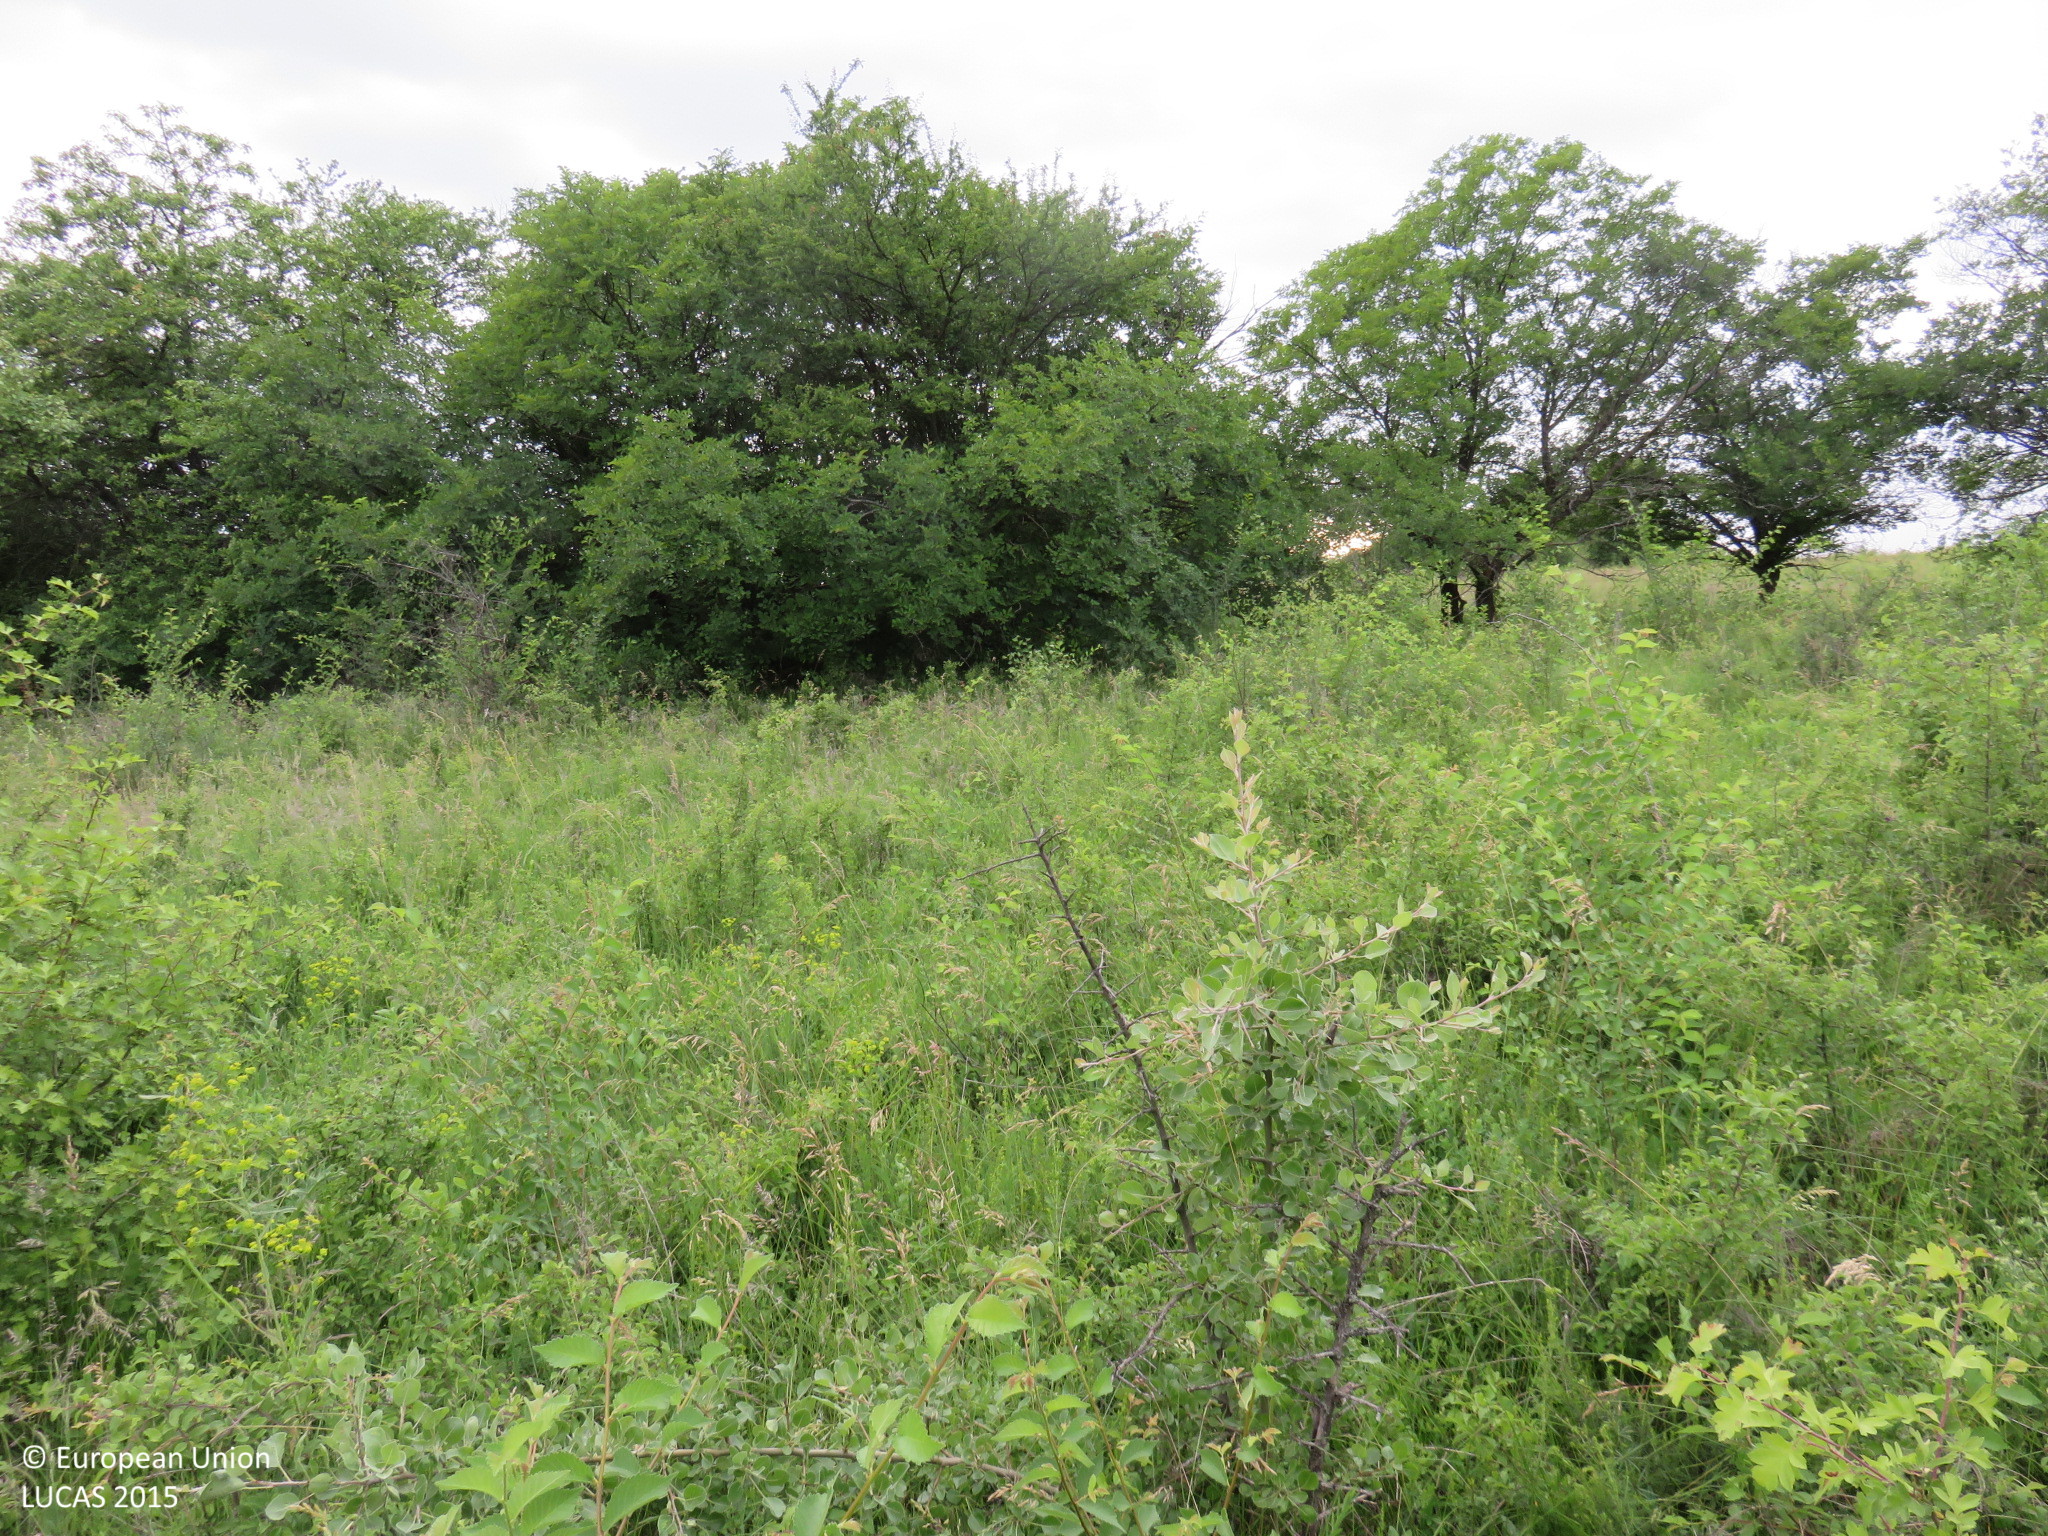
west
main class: Shrubland
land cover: Shrubland without tree cover
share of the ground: > 75 %
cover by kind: shrubs 85 %, herbaceous plants 15 %
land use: Fallow land
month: May
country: BG
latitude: 43.2196
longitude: 24.4741
